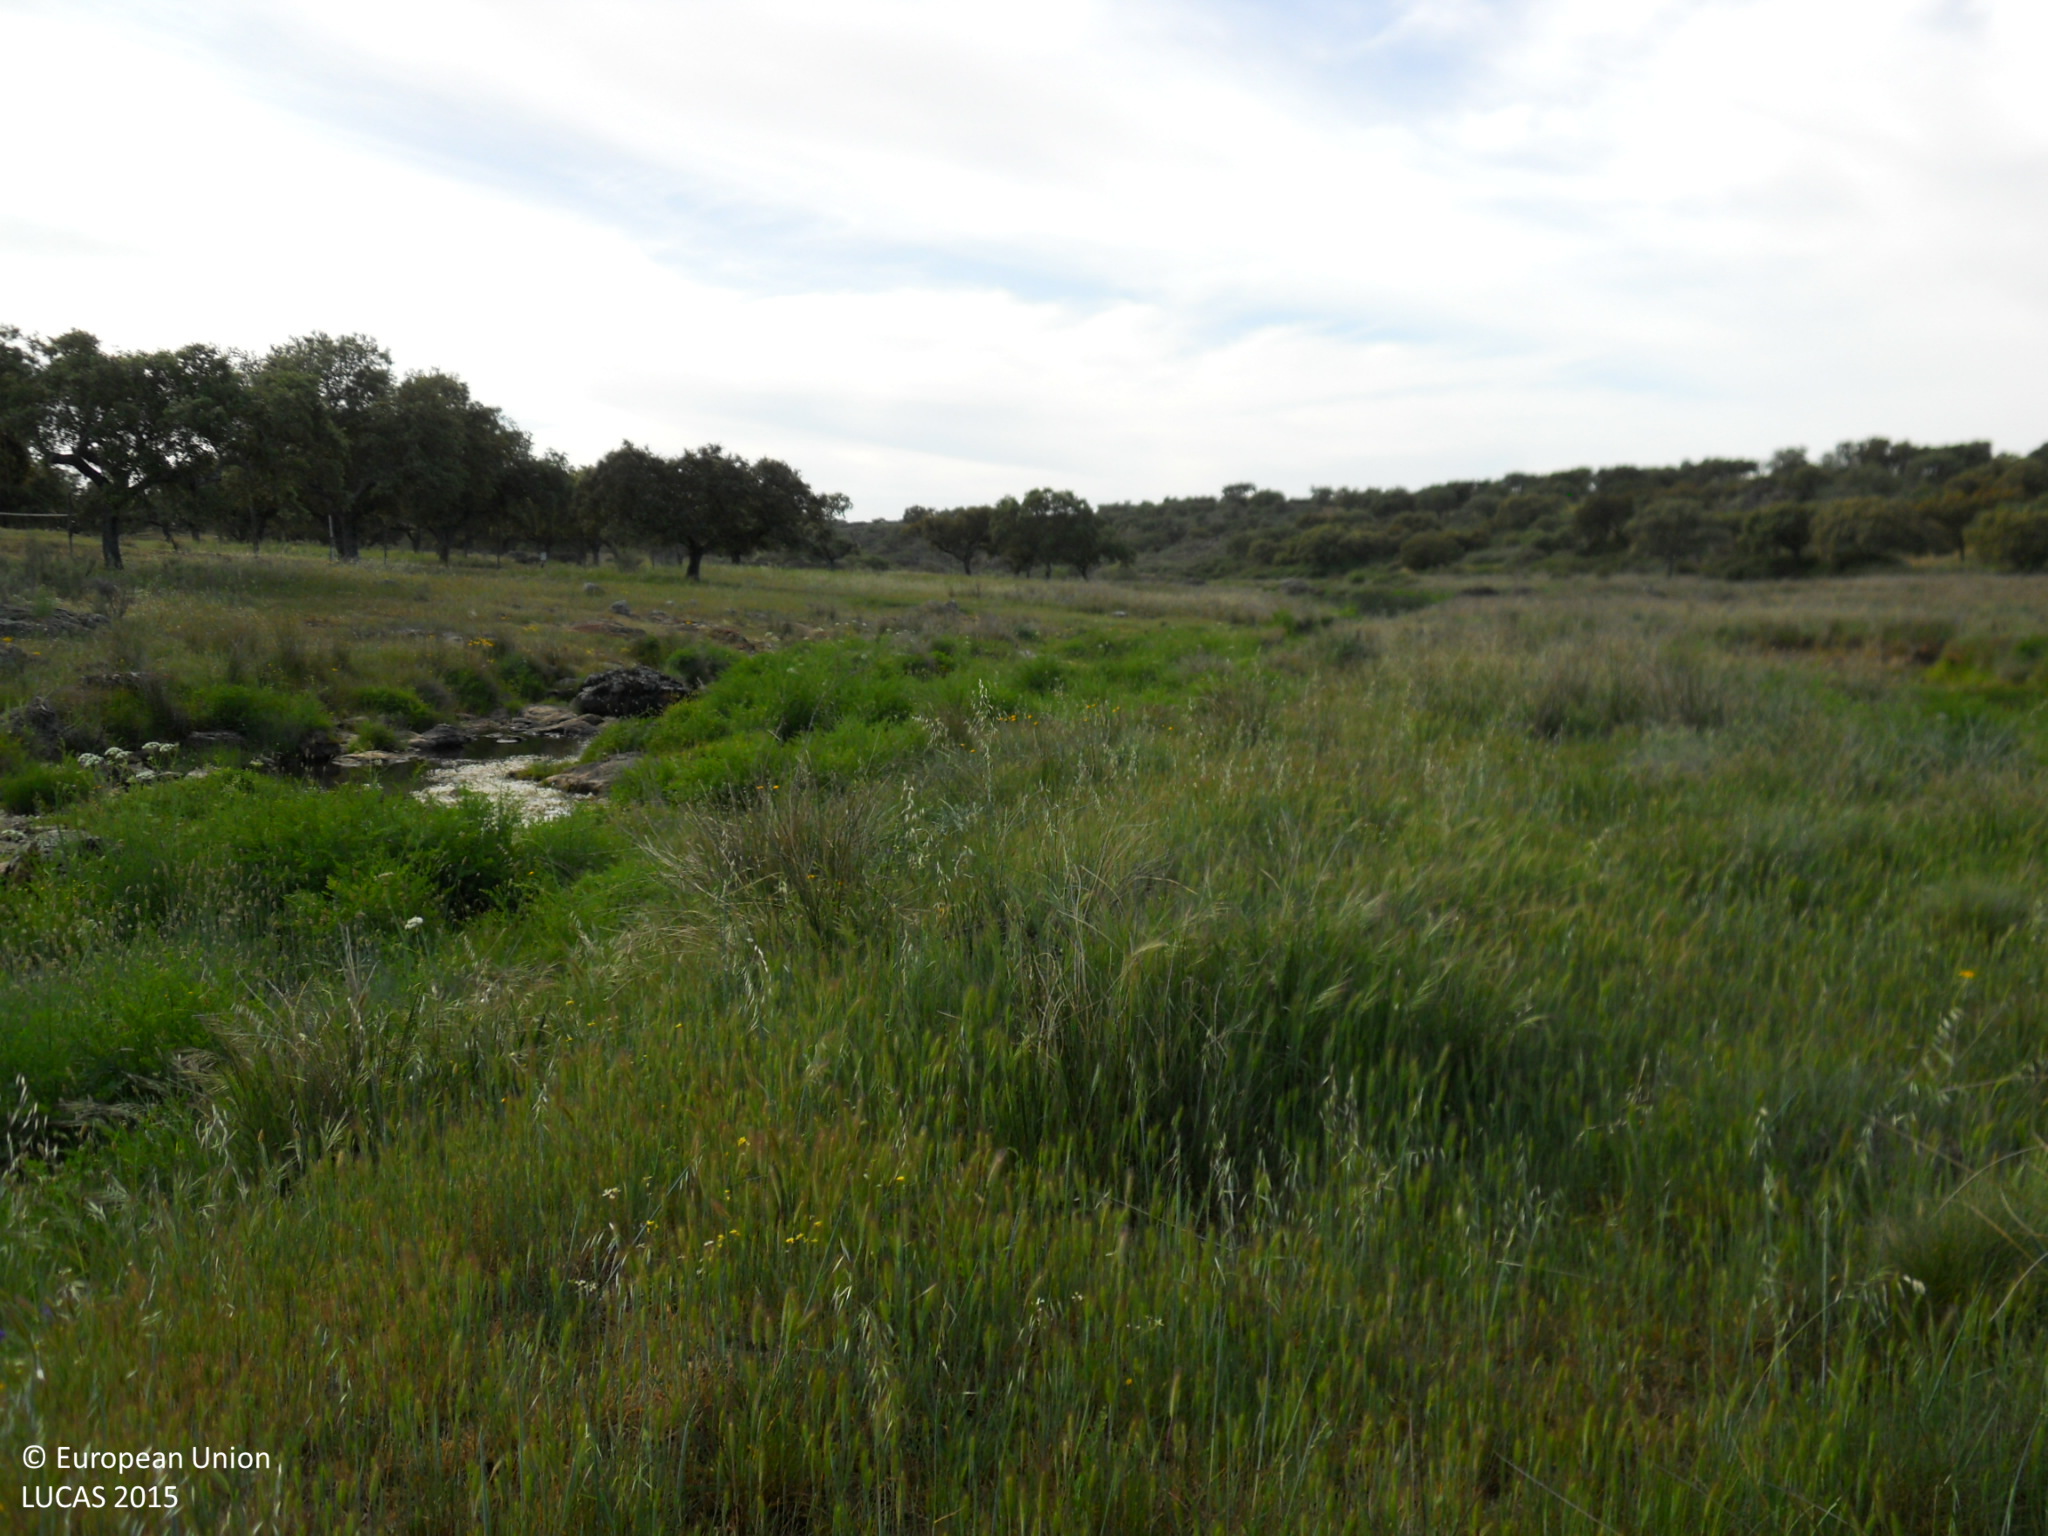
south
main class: Shrubland
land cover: Shrubland with sparse tree cover
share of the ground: > 75 %
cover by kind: shrubs 50 %, herbaceous plants 45 %, broadleaved forest trees 5 %
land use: Semi-natural and natural areas not in use
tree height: < 5 m
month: April
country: ES
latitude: 39.3186
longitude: -6.9301
